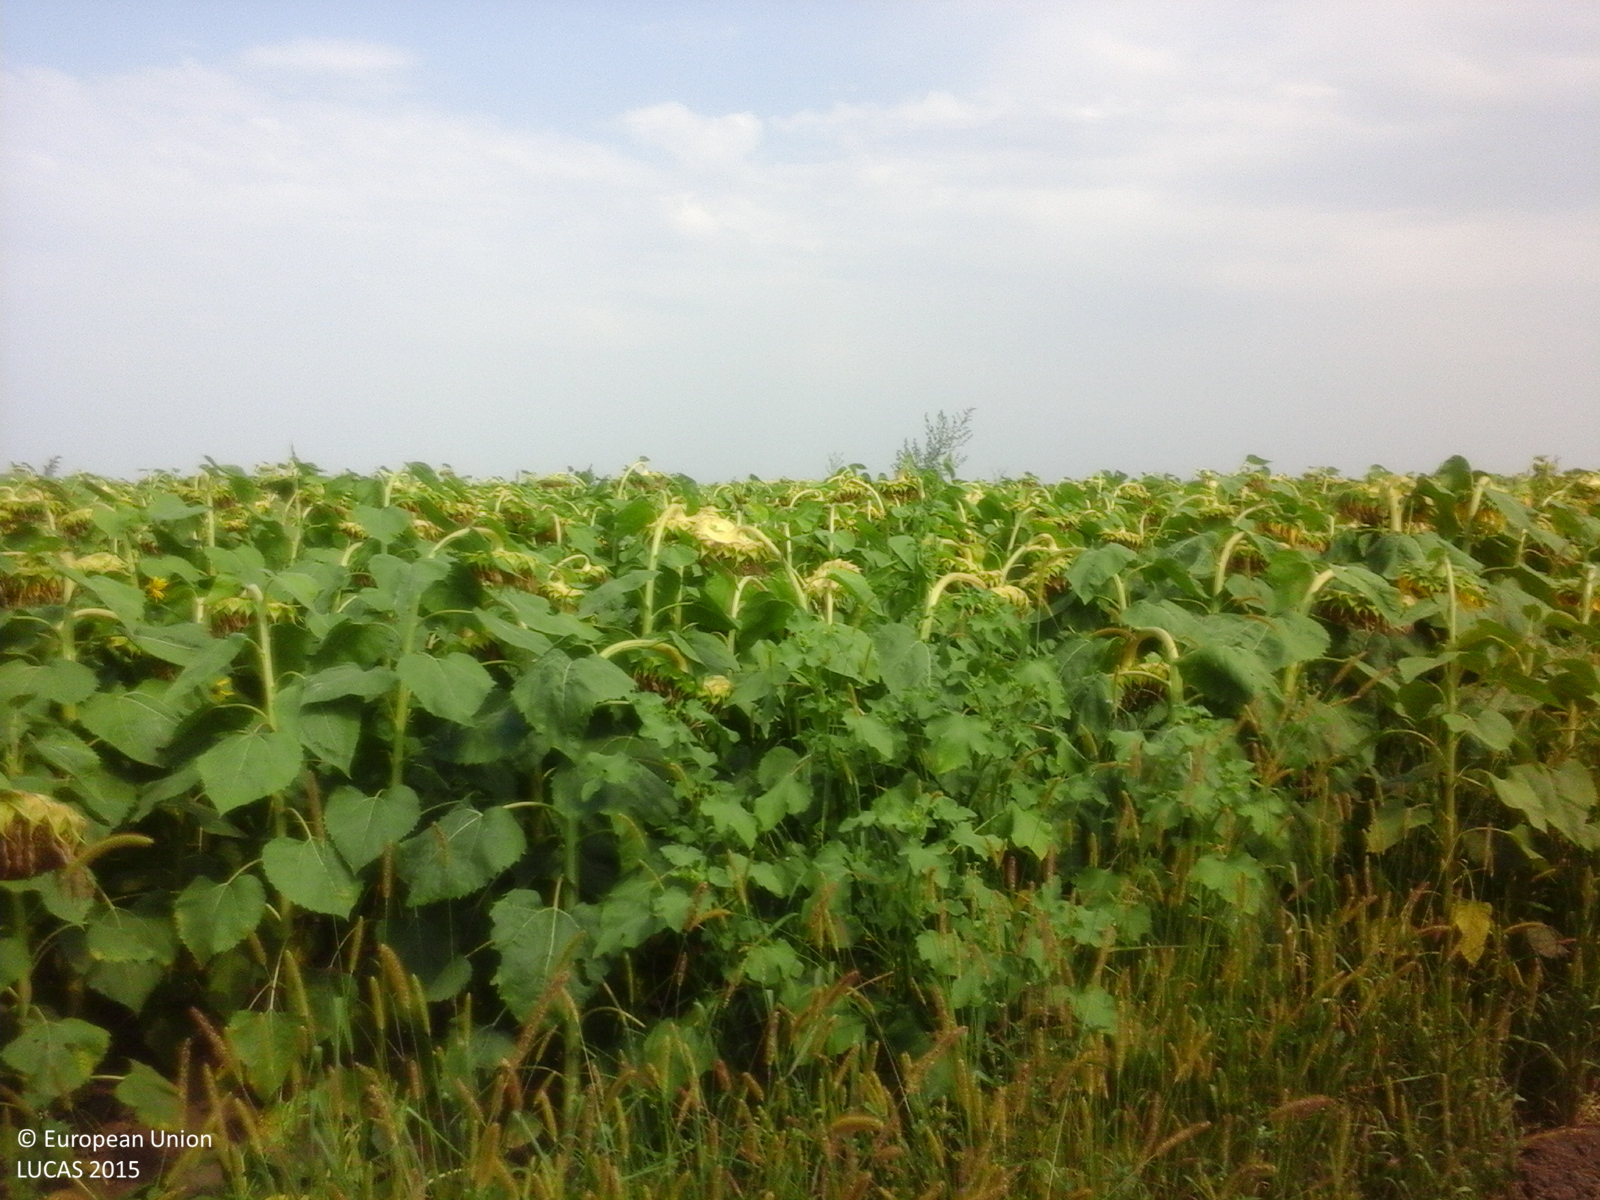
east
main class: Cropland
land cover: Maize
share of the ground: > 75 %
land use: Agriculture (excluding fallow land and kitchen gardens)
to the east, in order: Maize; Tracks; Grass margins; Sunflower
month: August
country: RO
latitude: 45.0985
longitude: 27.7048
